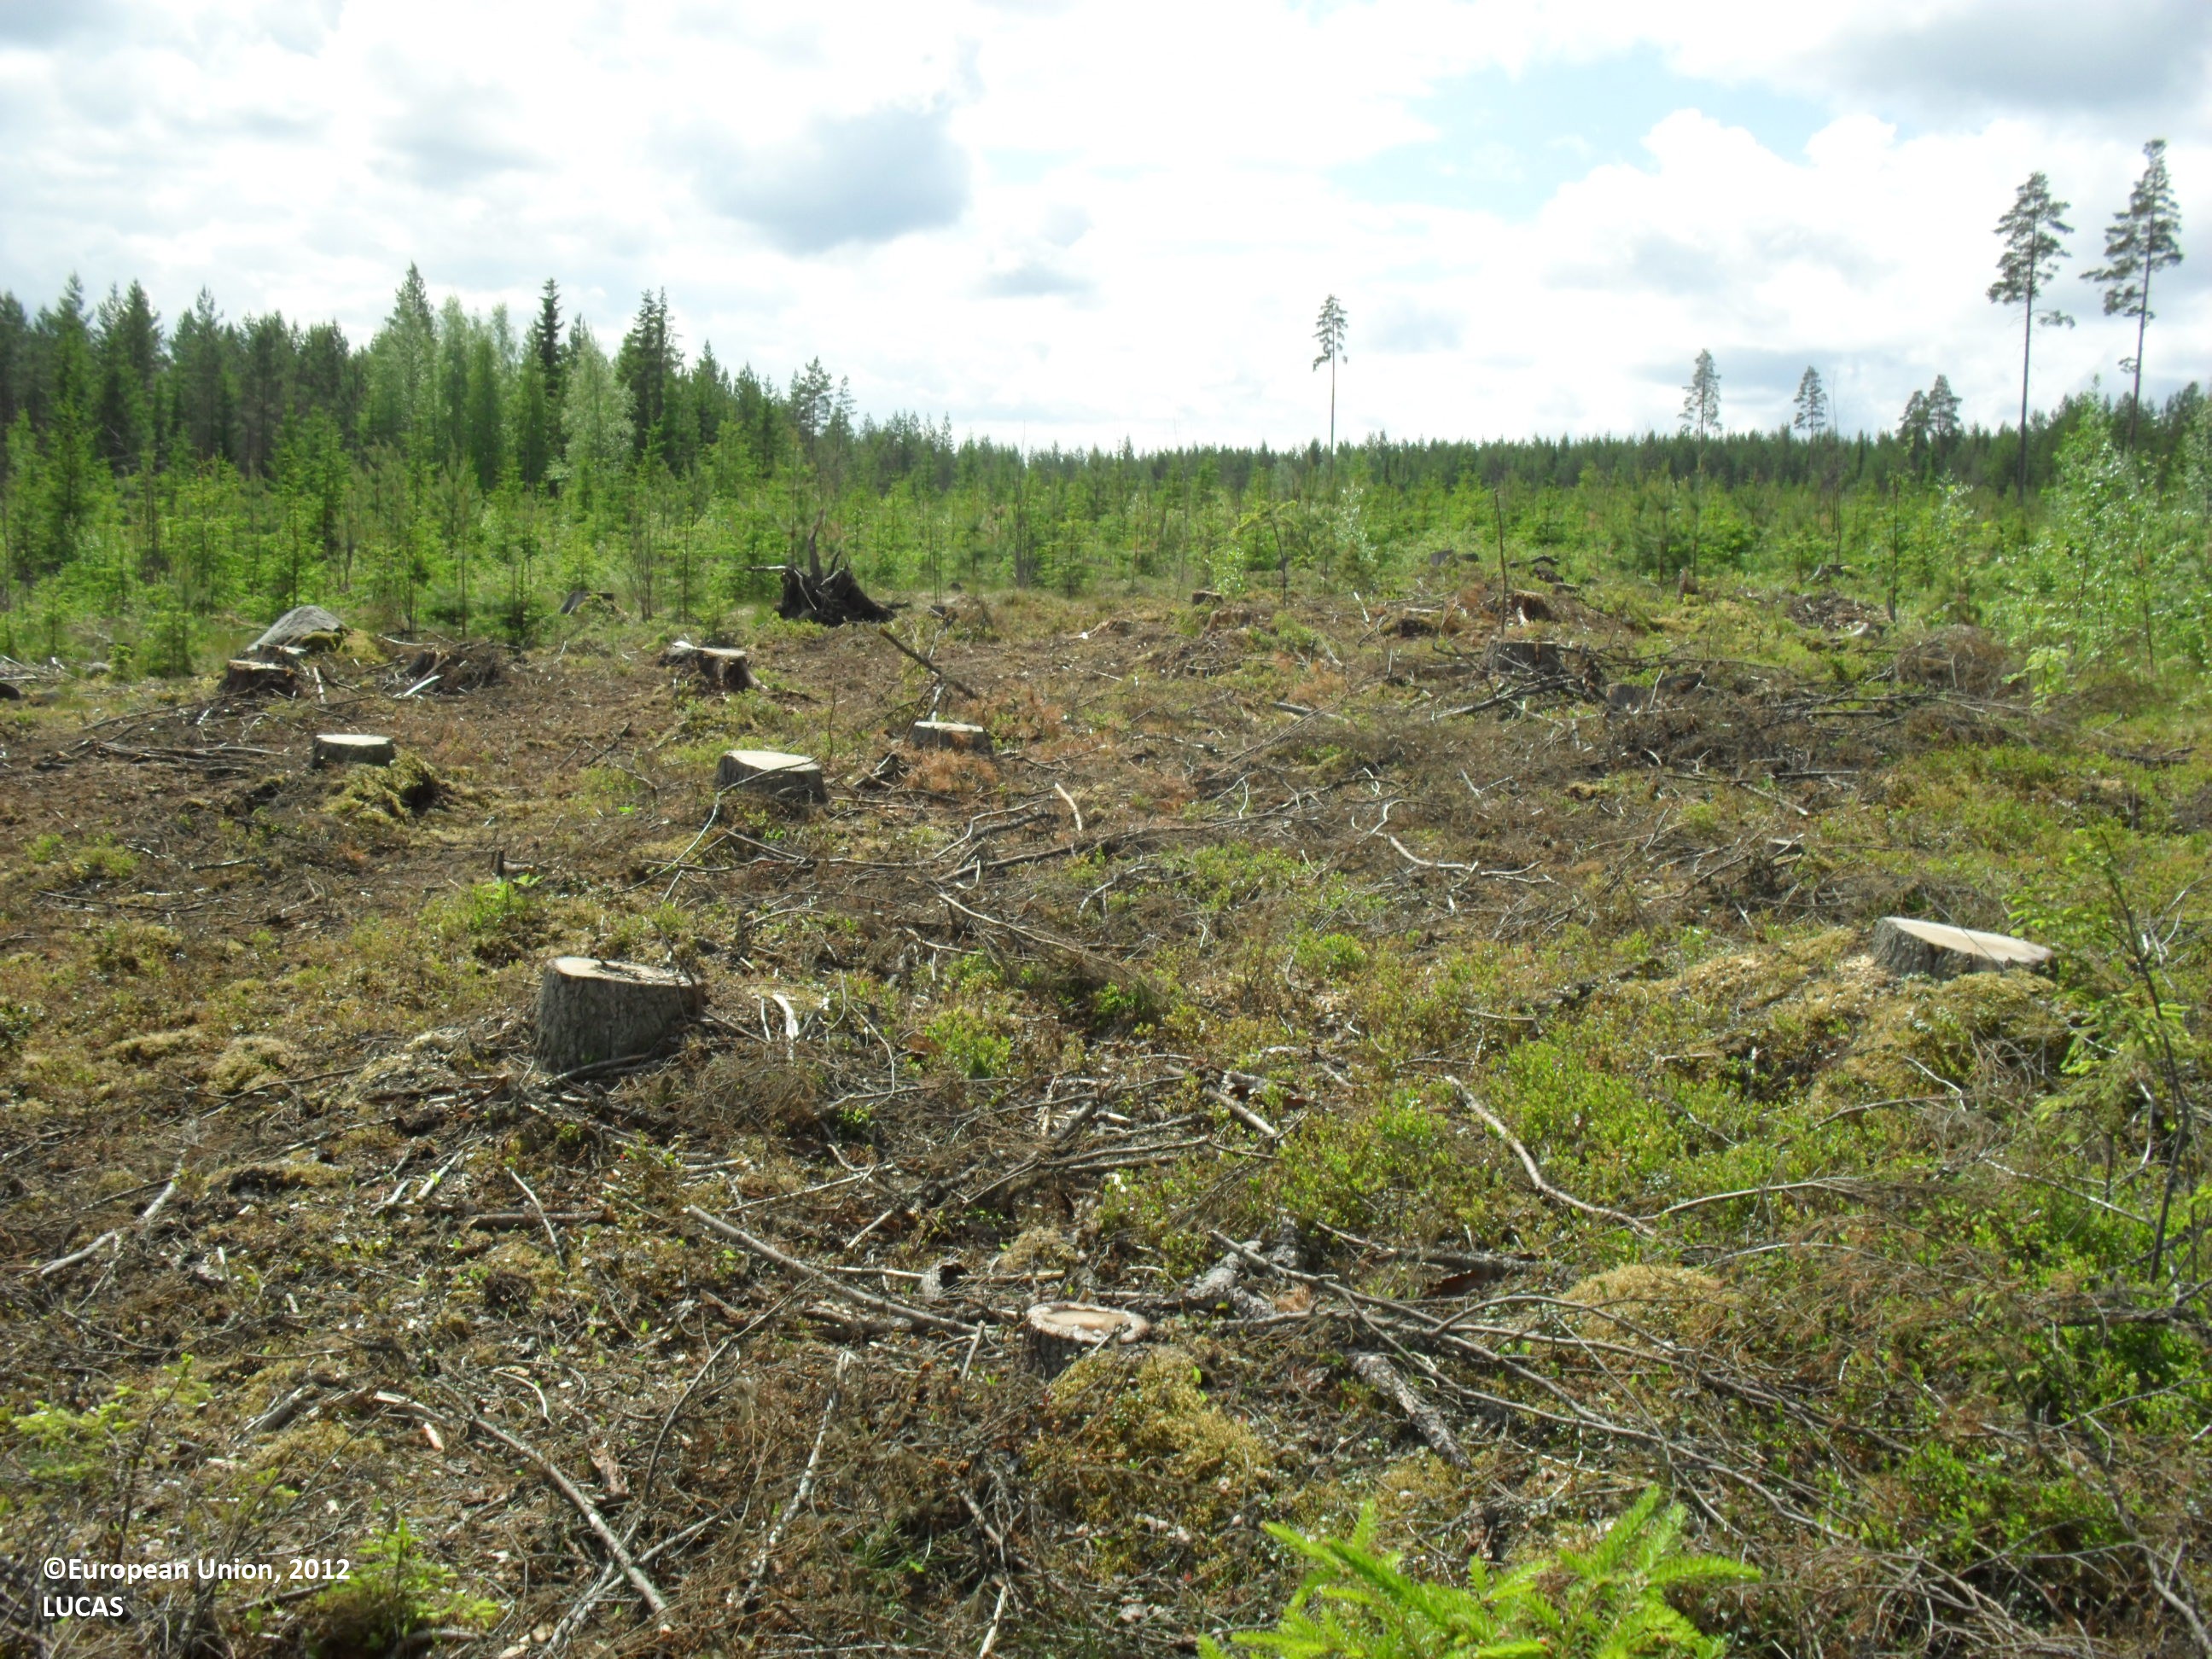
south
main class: Grassland
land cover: Grassland with sparse tree/shrub cover
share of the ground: < 10 %
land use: Forestry
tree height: < 5 m
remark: Clear cut
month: June
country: FI
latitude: 62.7934
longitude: 23.4582
